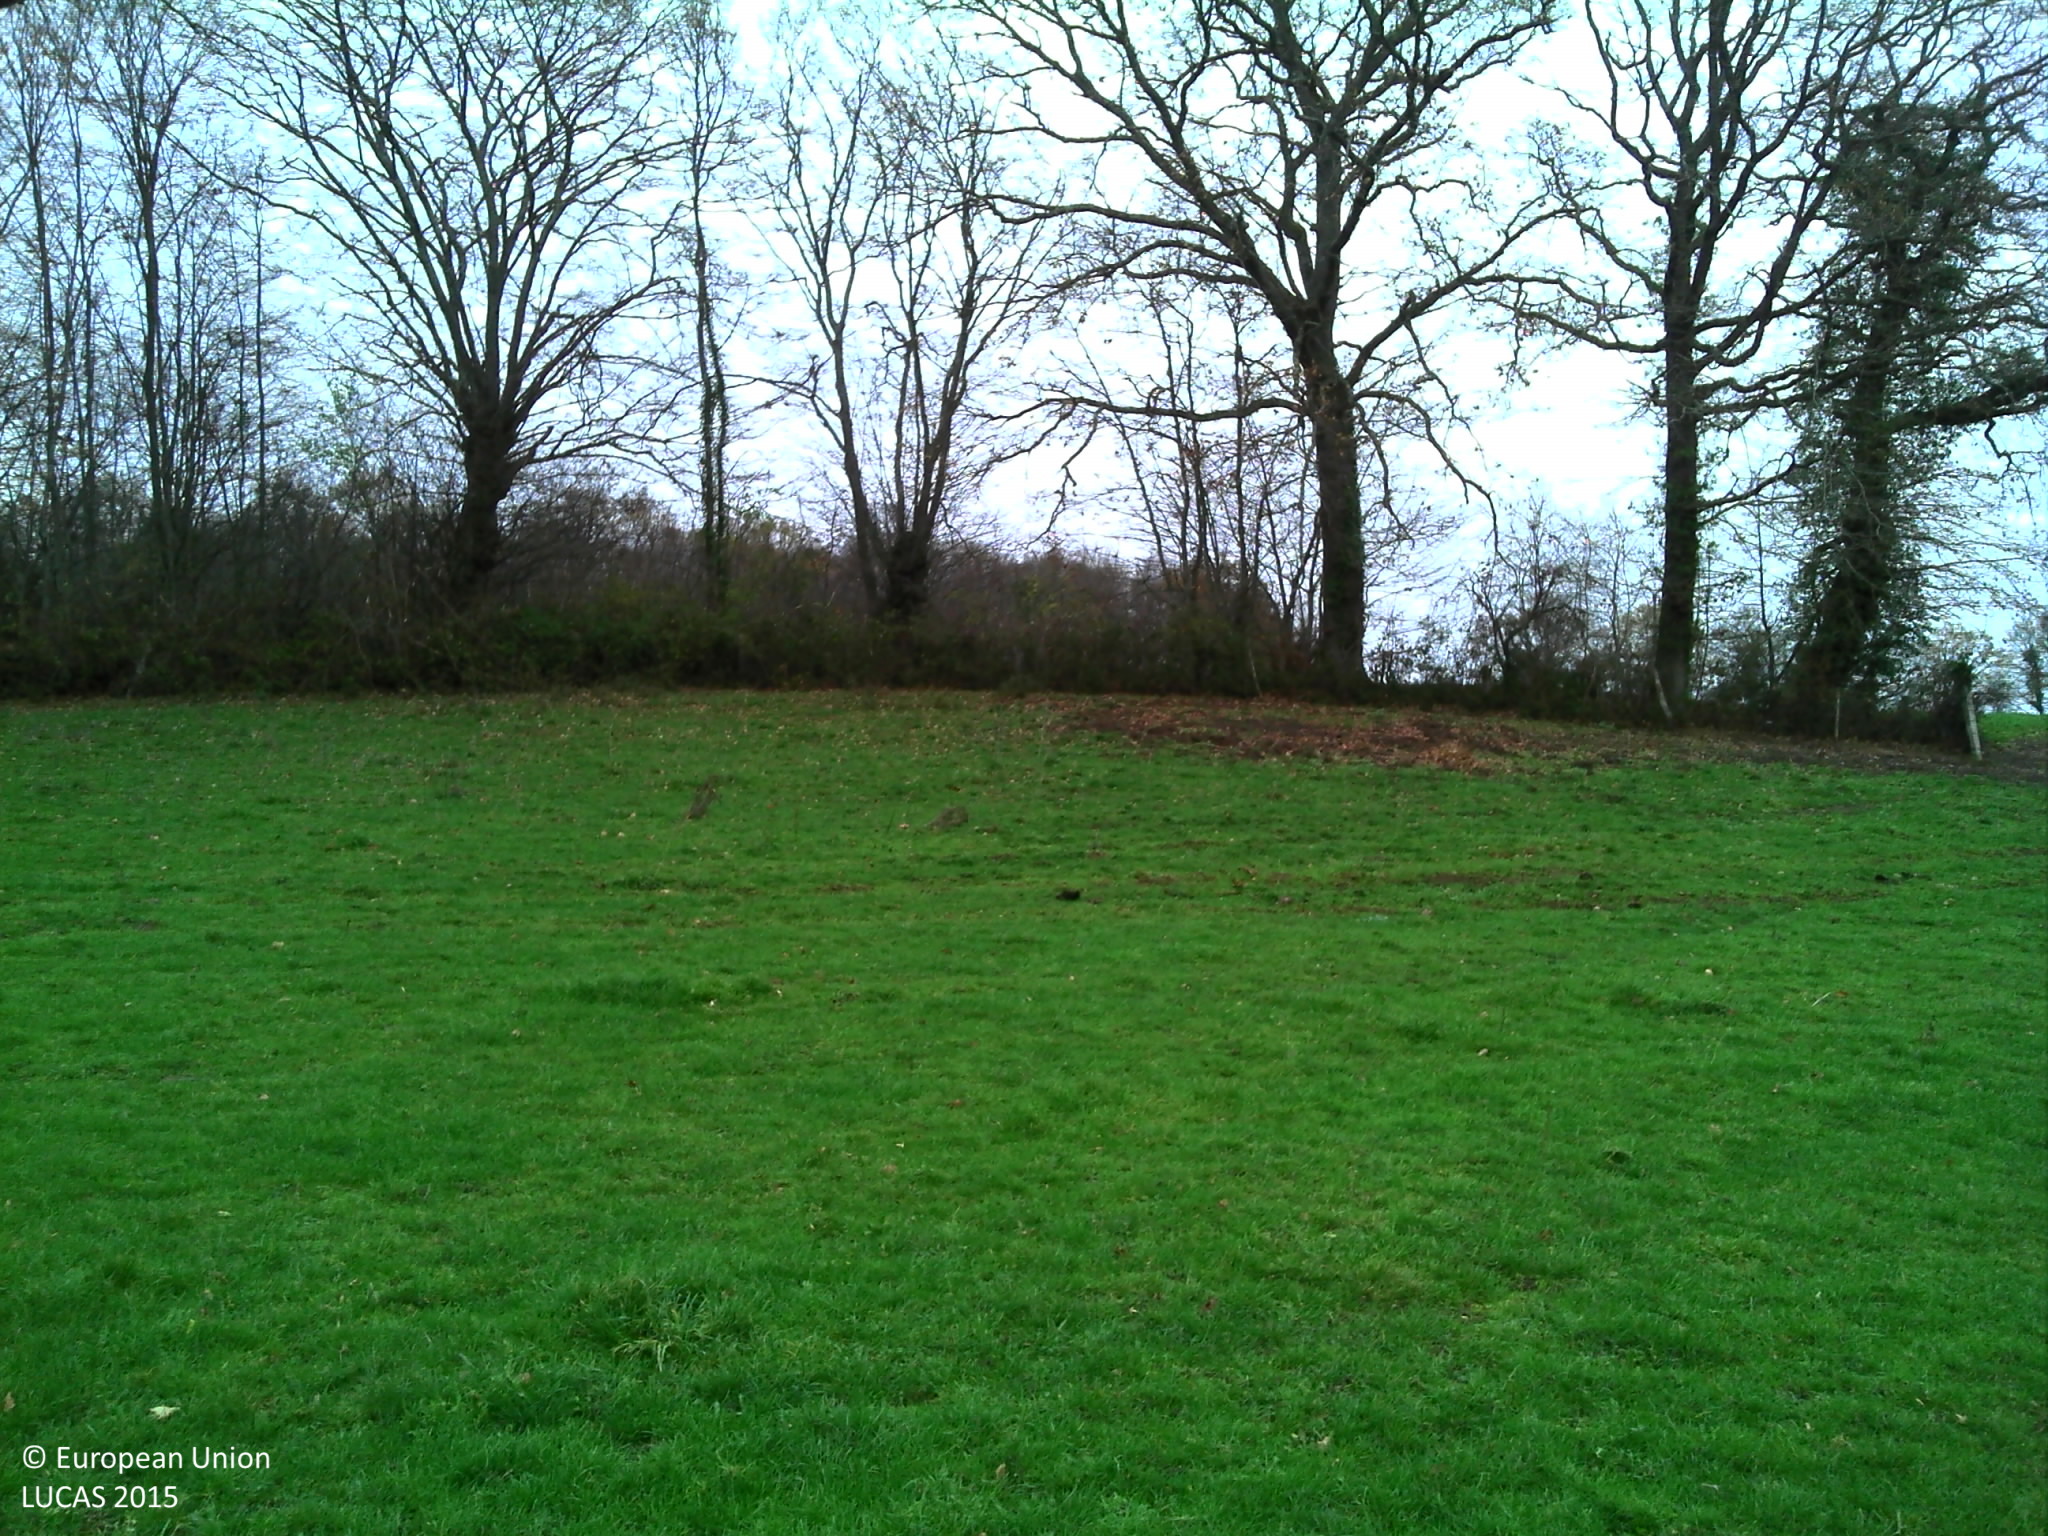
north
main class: Grassland
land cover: Grassland without tree/shrub cover
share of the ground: > 75 %
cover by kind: herbaceous plants 100 %
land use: Agriculture (excluding fallow land and kitchen gardens)
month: July
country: FR
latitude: 46.6822
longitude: 3.0020
